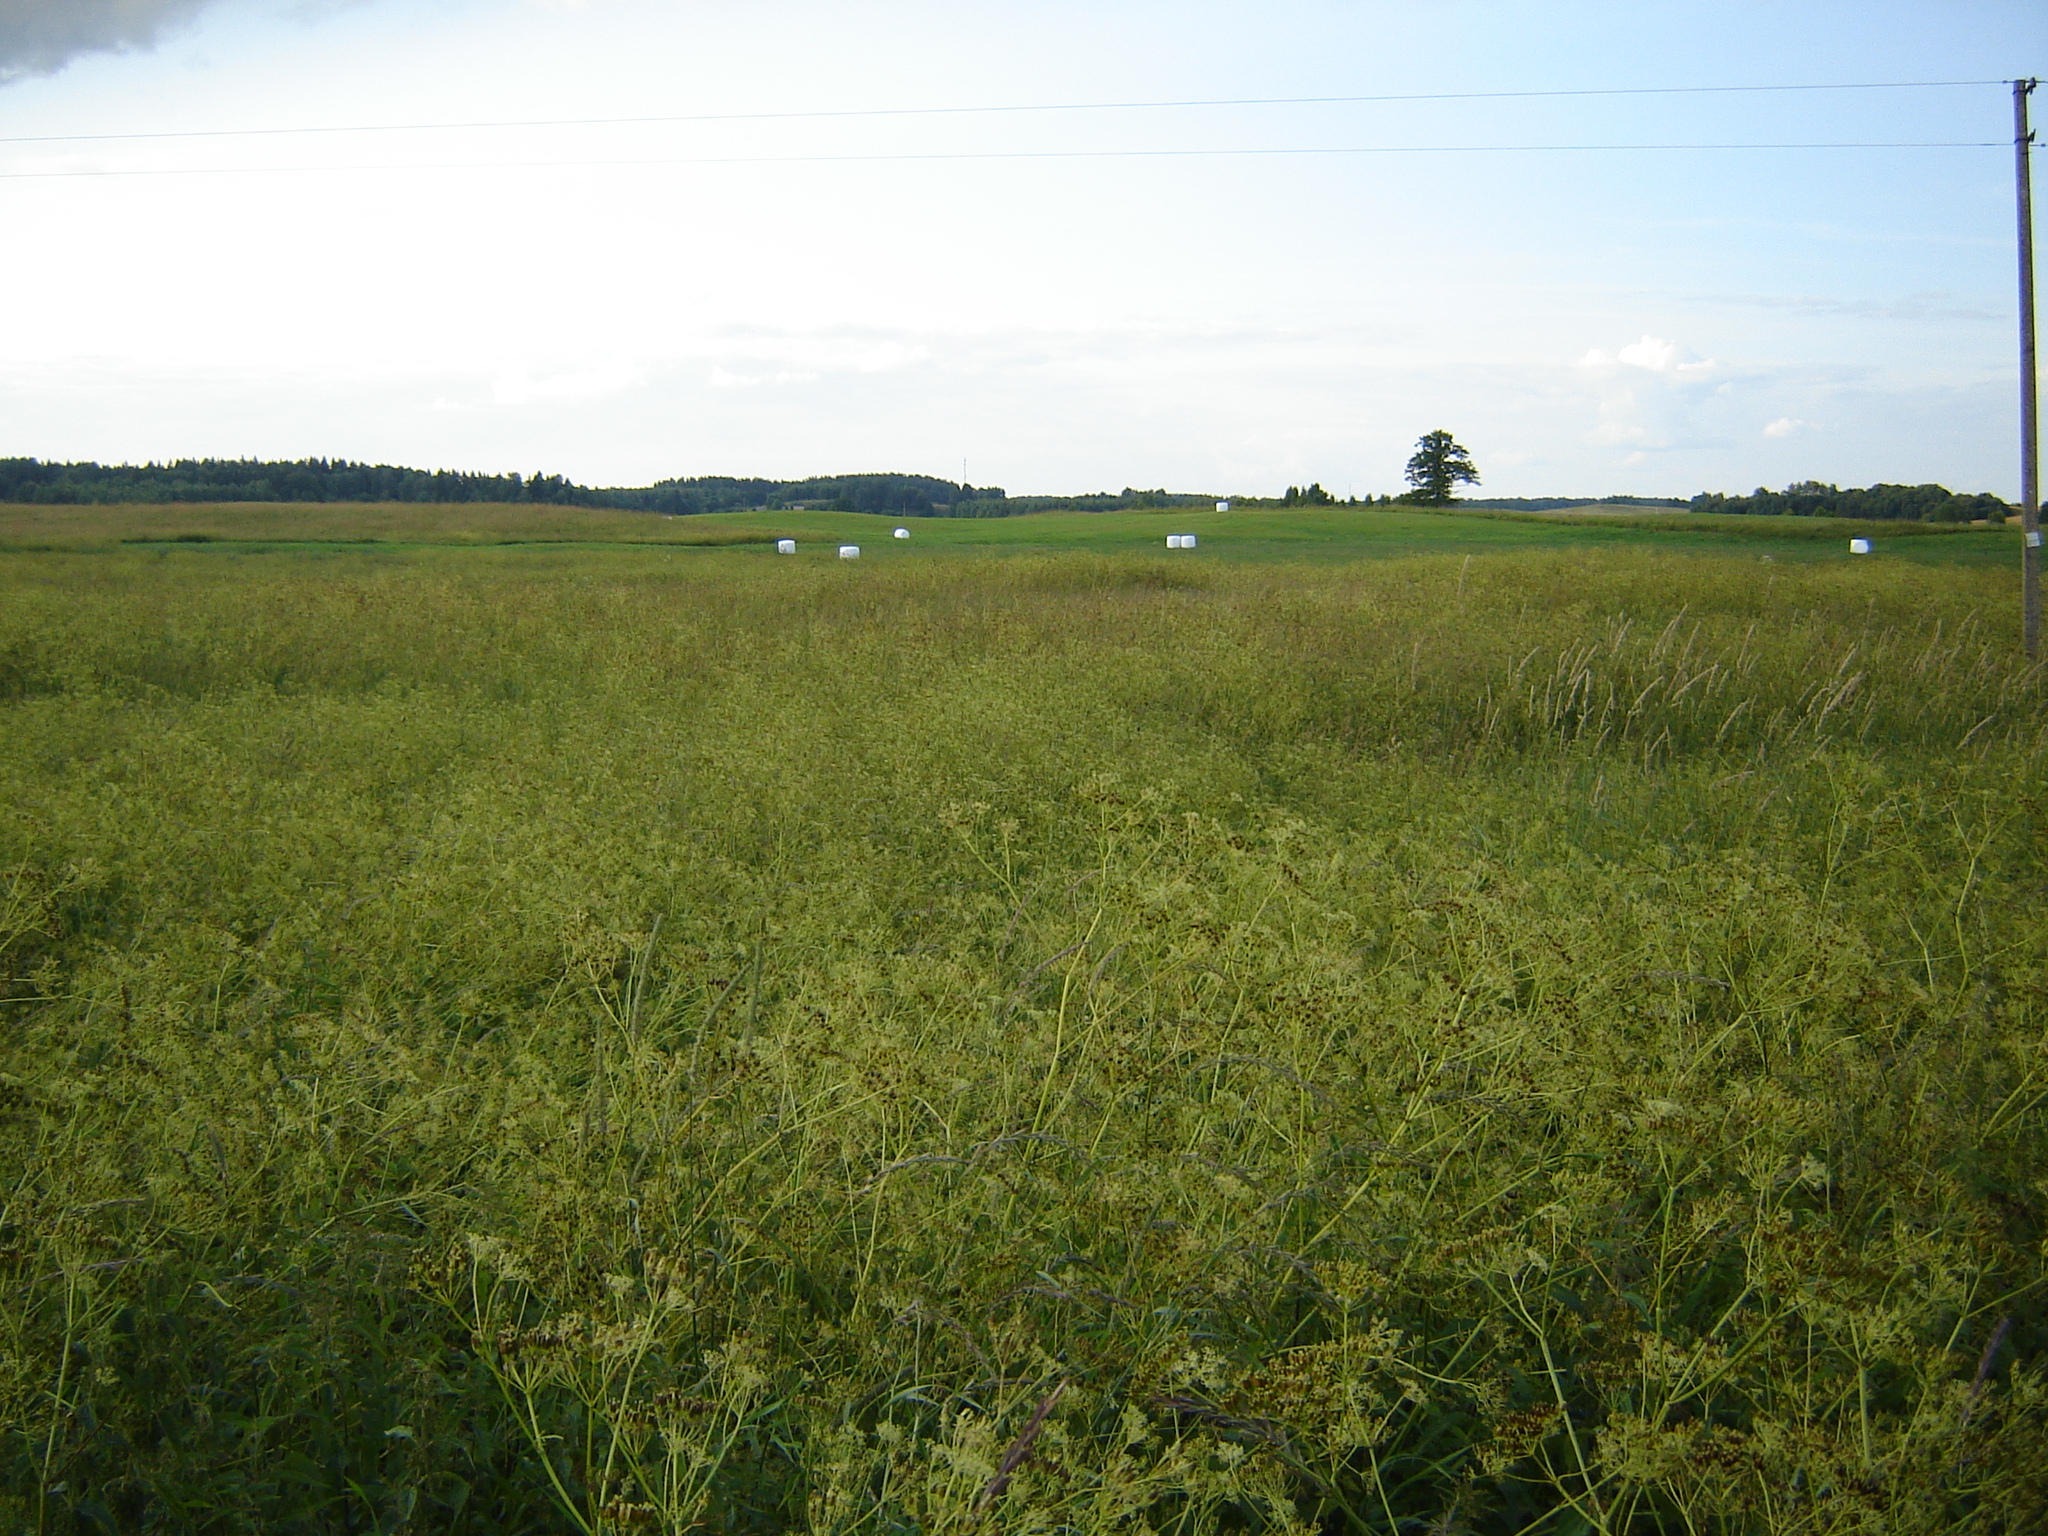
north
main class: Grassland
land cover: Spontaneously vegetated surfaces
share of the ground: > 75 %
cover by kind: herbaceous plants 100 %
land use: Fallow land
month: July
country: LT
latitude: 55.3649
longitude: 25.5073
